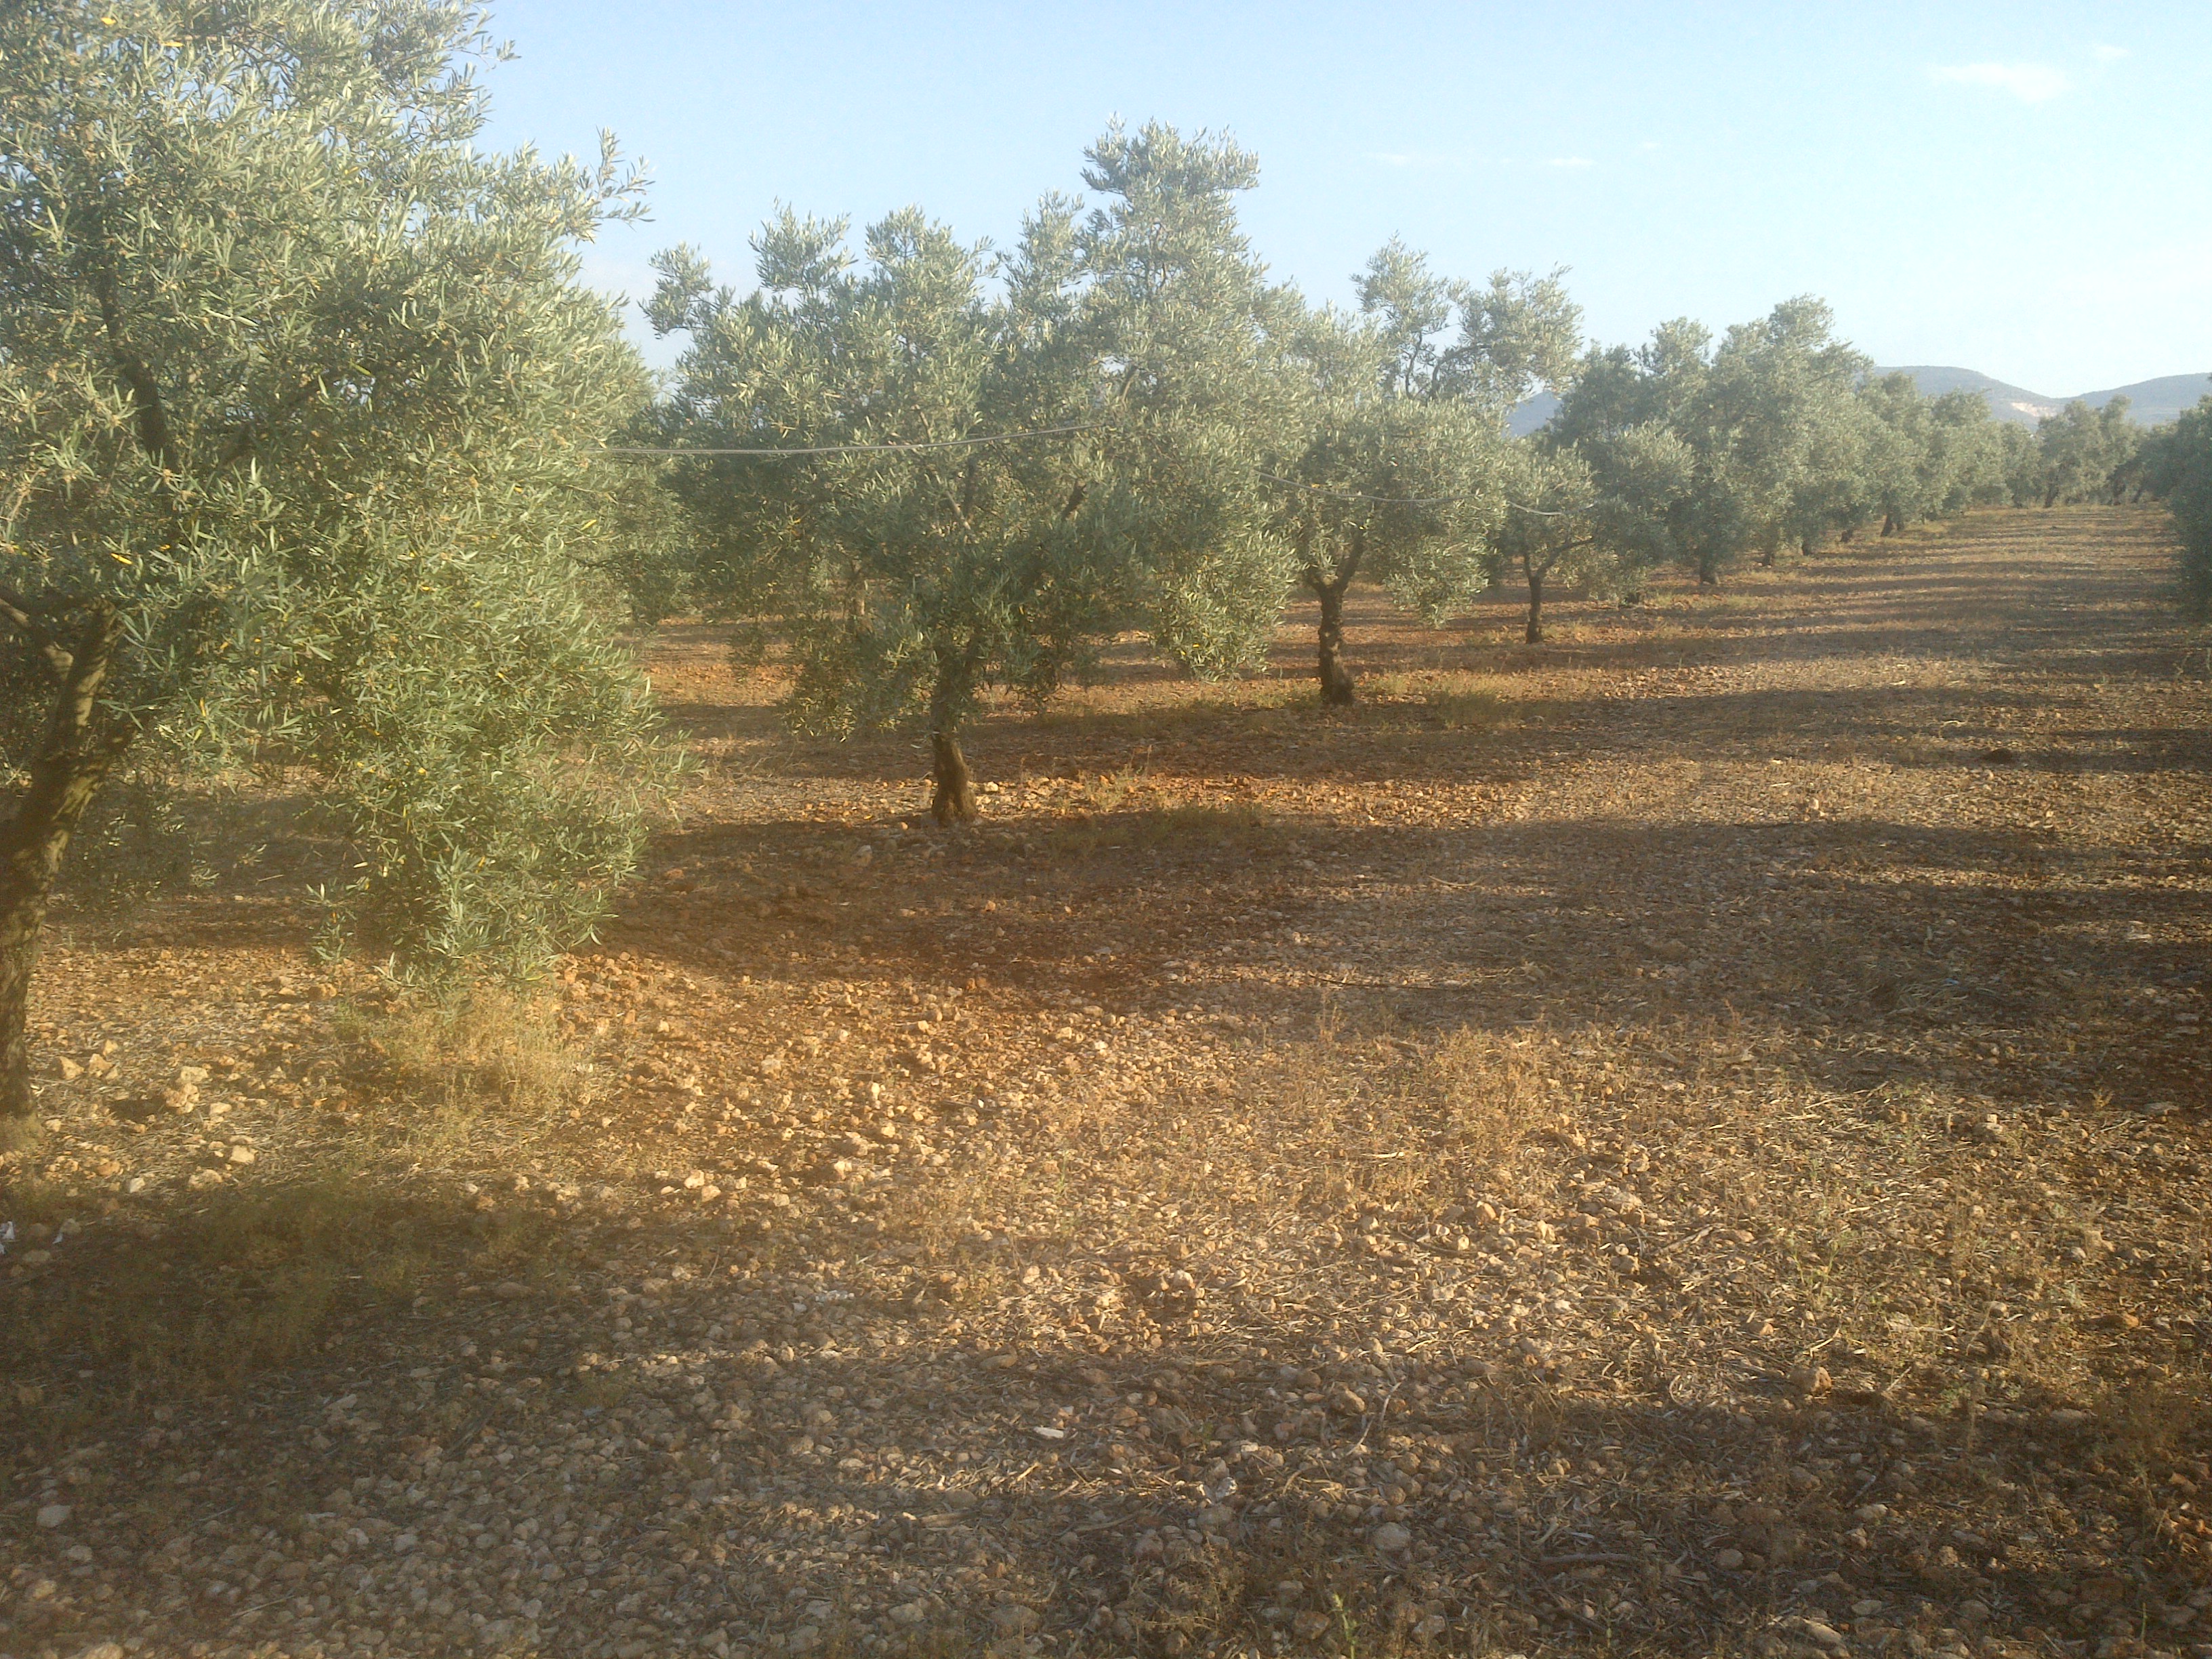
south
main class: Cropland
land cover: Olive groves
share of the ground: 50 - 75 %
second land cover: Other bare soil
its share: > 75 %
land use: Agriculture (excluding fallow land and kitchen gardens)
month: May
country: ES
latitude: 37.3508
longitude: -4.8285
